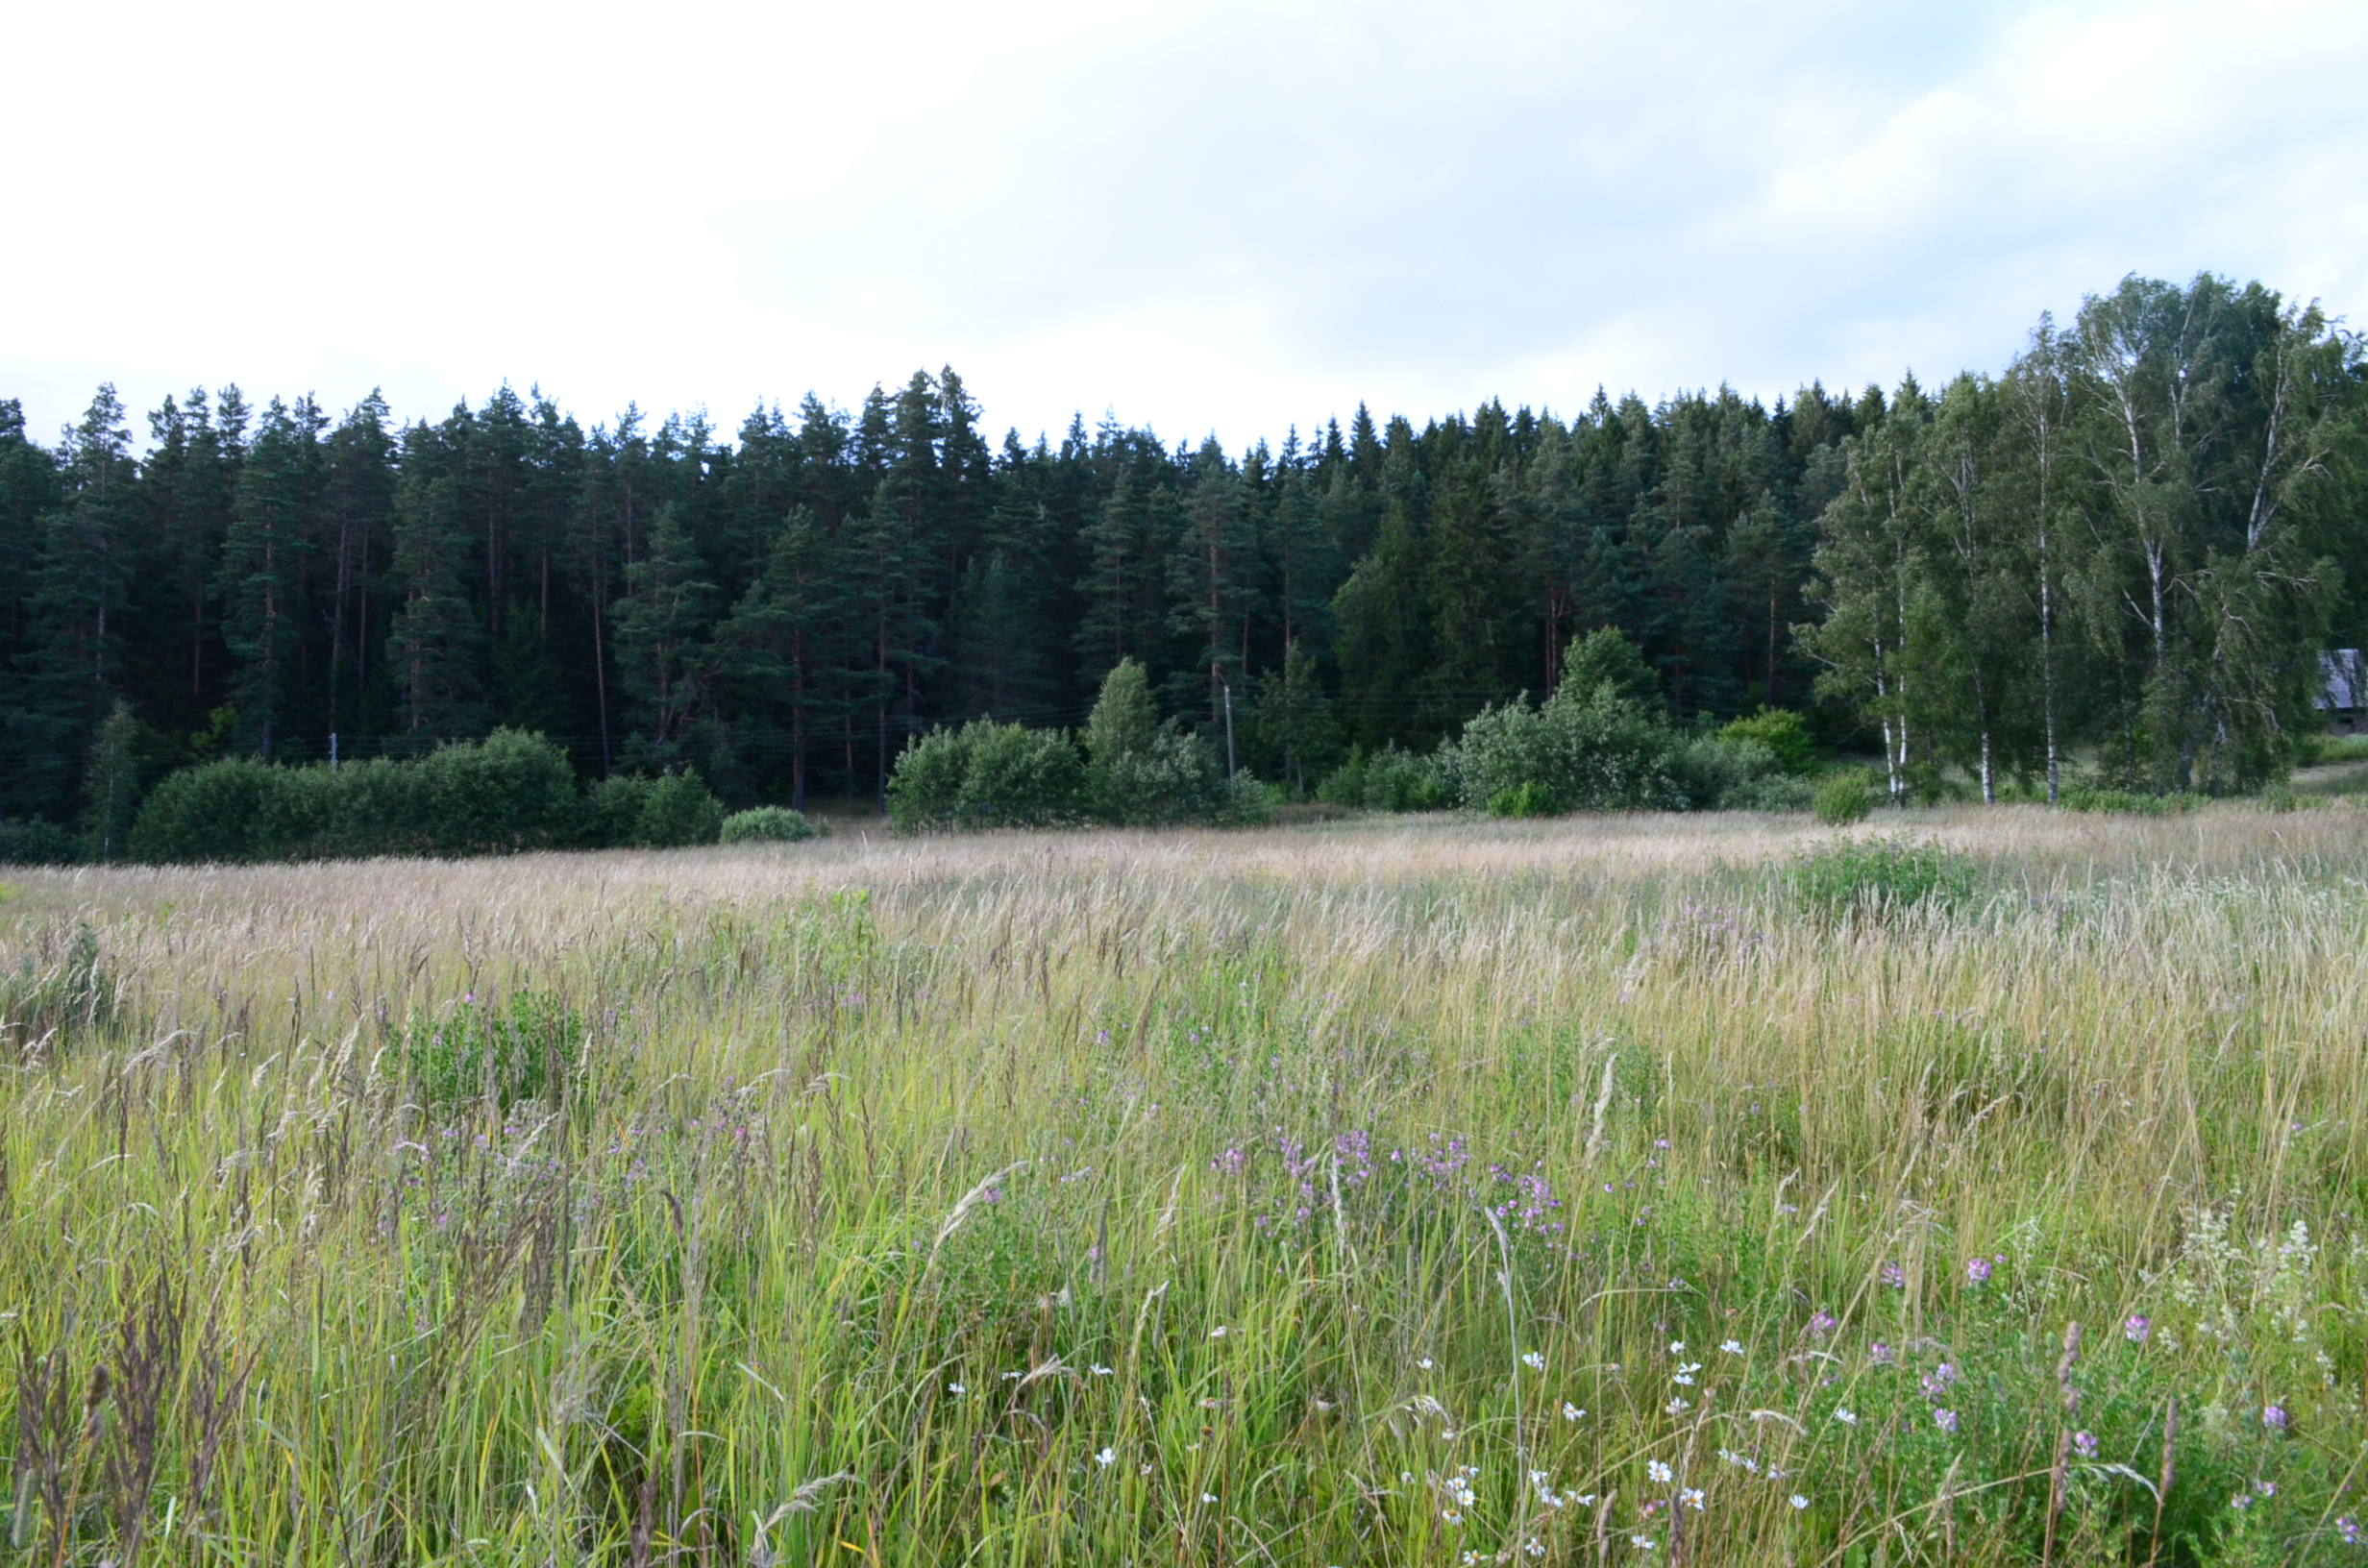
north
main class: Grassland
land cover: Spontaneously vegetated surfaces
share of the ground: > 75 %
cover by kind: herbaceous plants 100 %
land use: Semi-natural and natural areas not in use
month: July
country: LV
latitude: 57.0712
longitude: 22.2734
